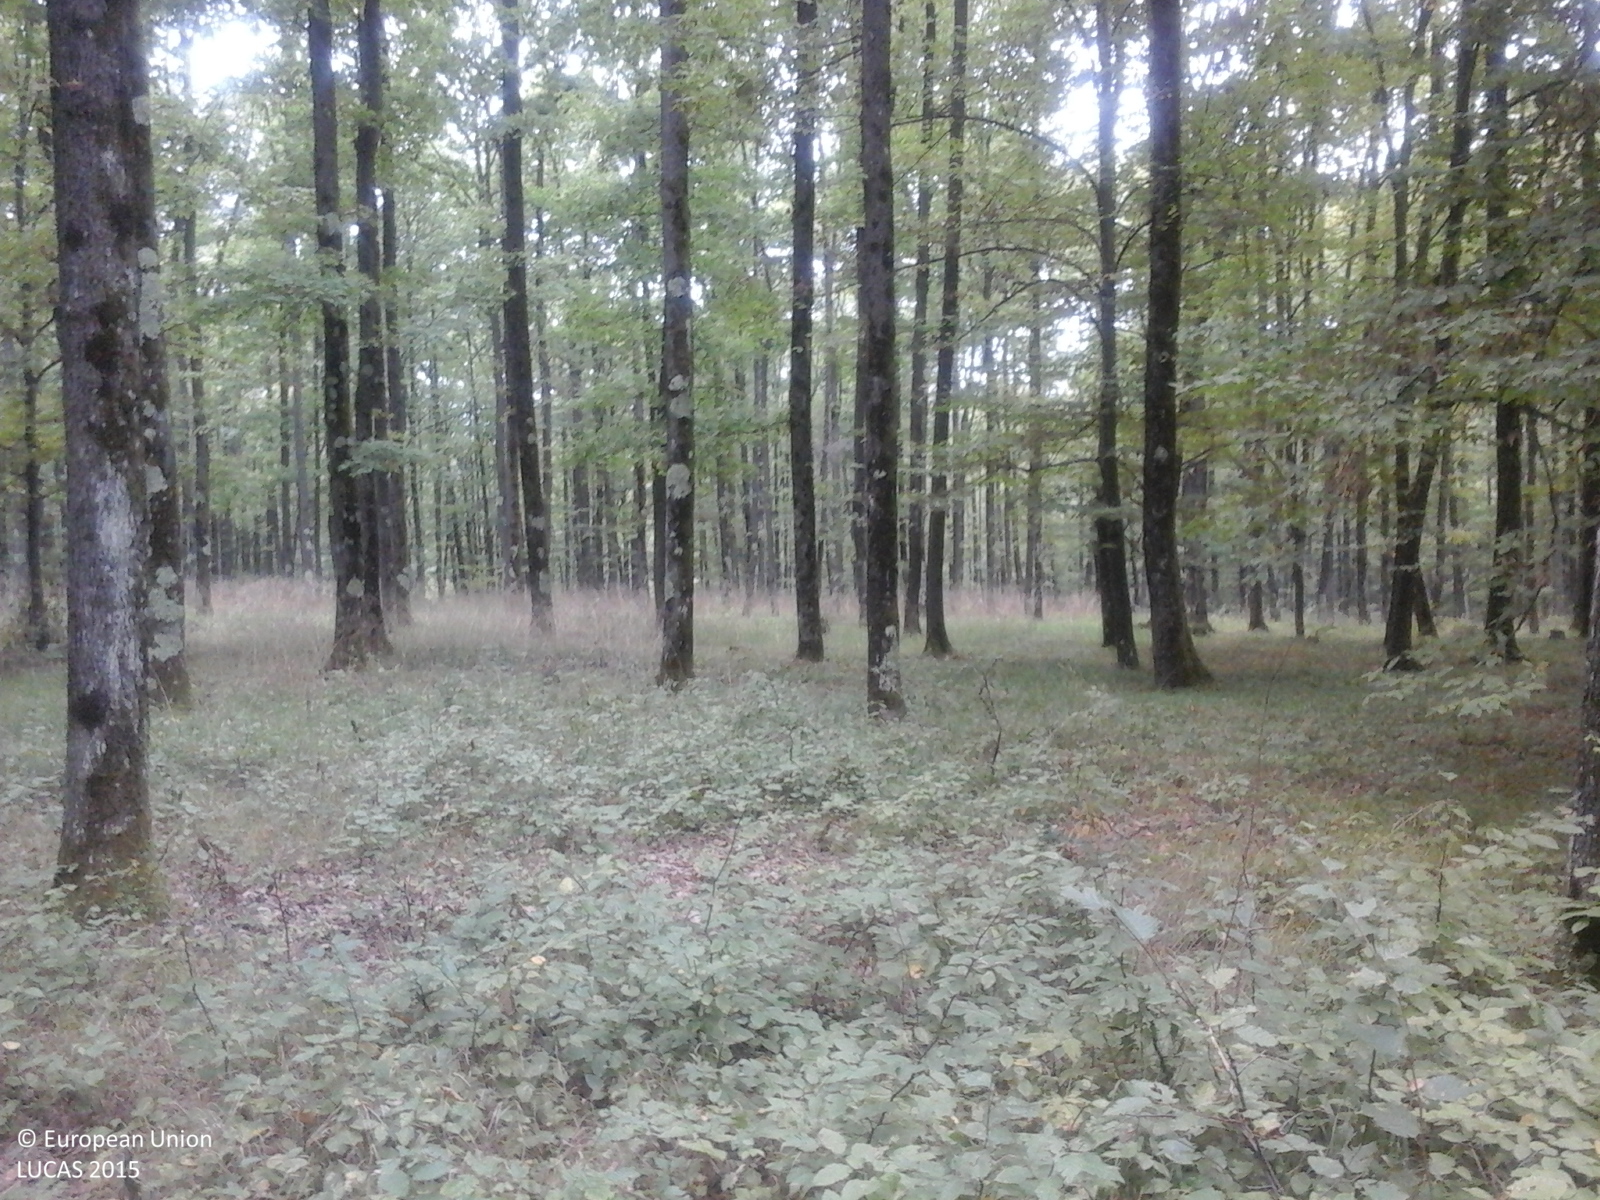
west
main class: Woodland
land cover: Broadleaved woodland
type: acidophilous oak and oak-birch forest
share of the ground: > 75 %
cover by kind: broadleaved forest trees 100 %
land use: Forestry
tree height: > 5 m
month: September
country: RO
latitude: 44.9475
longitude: 23.3240
